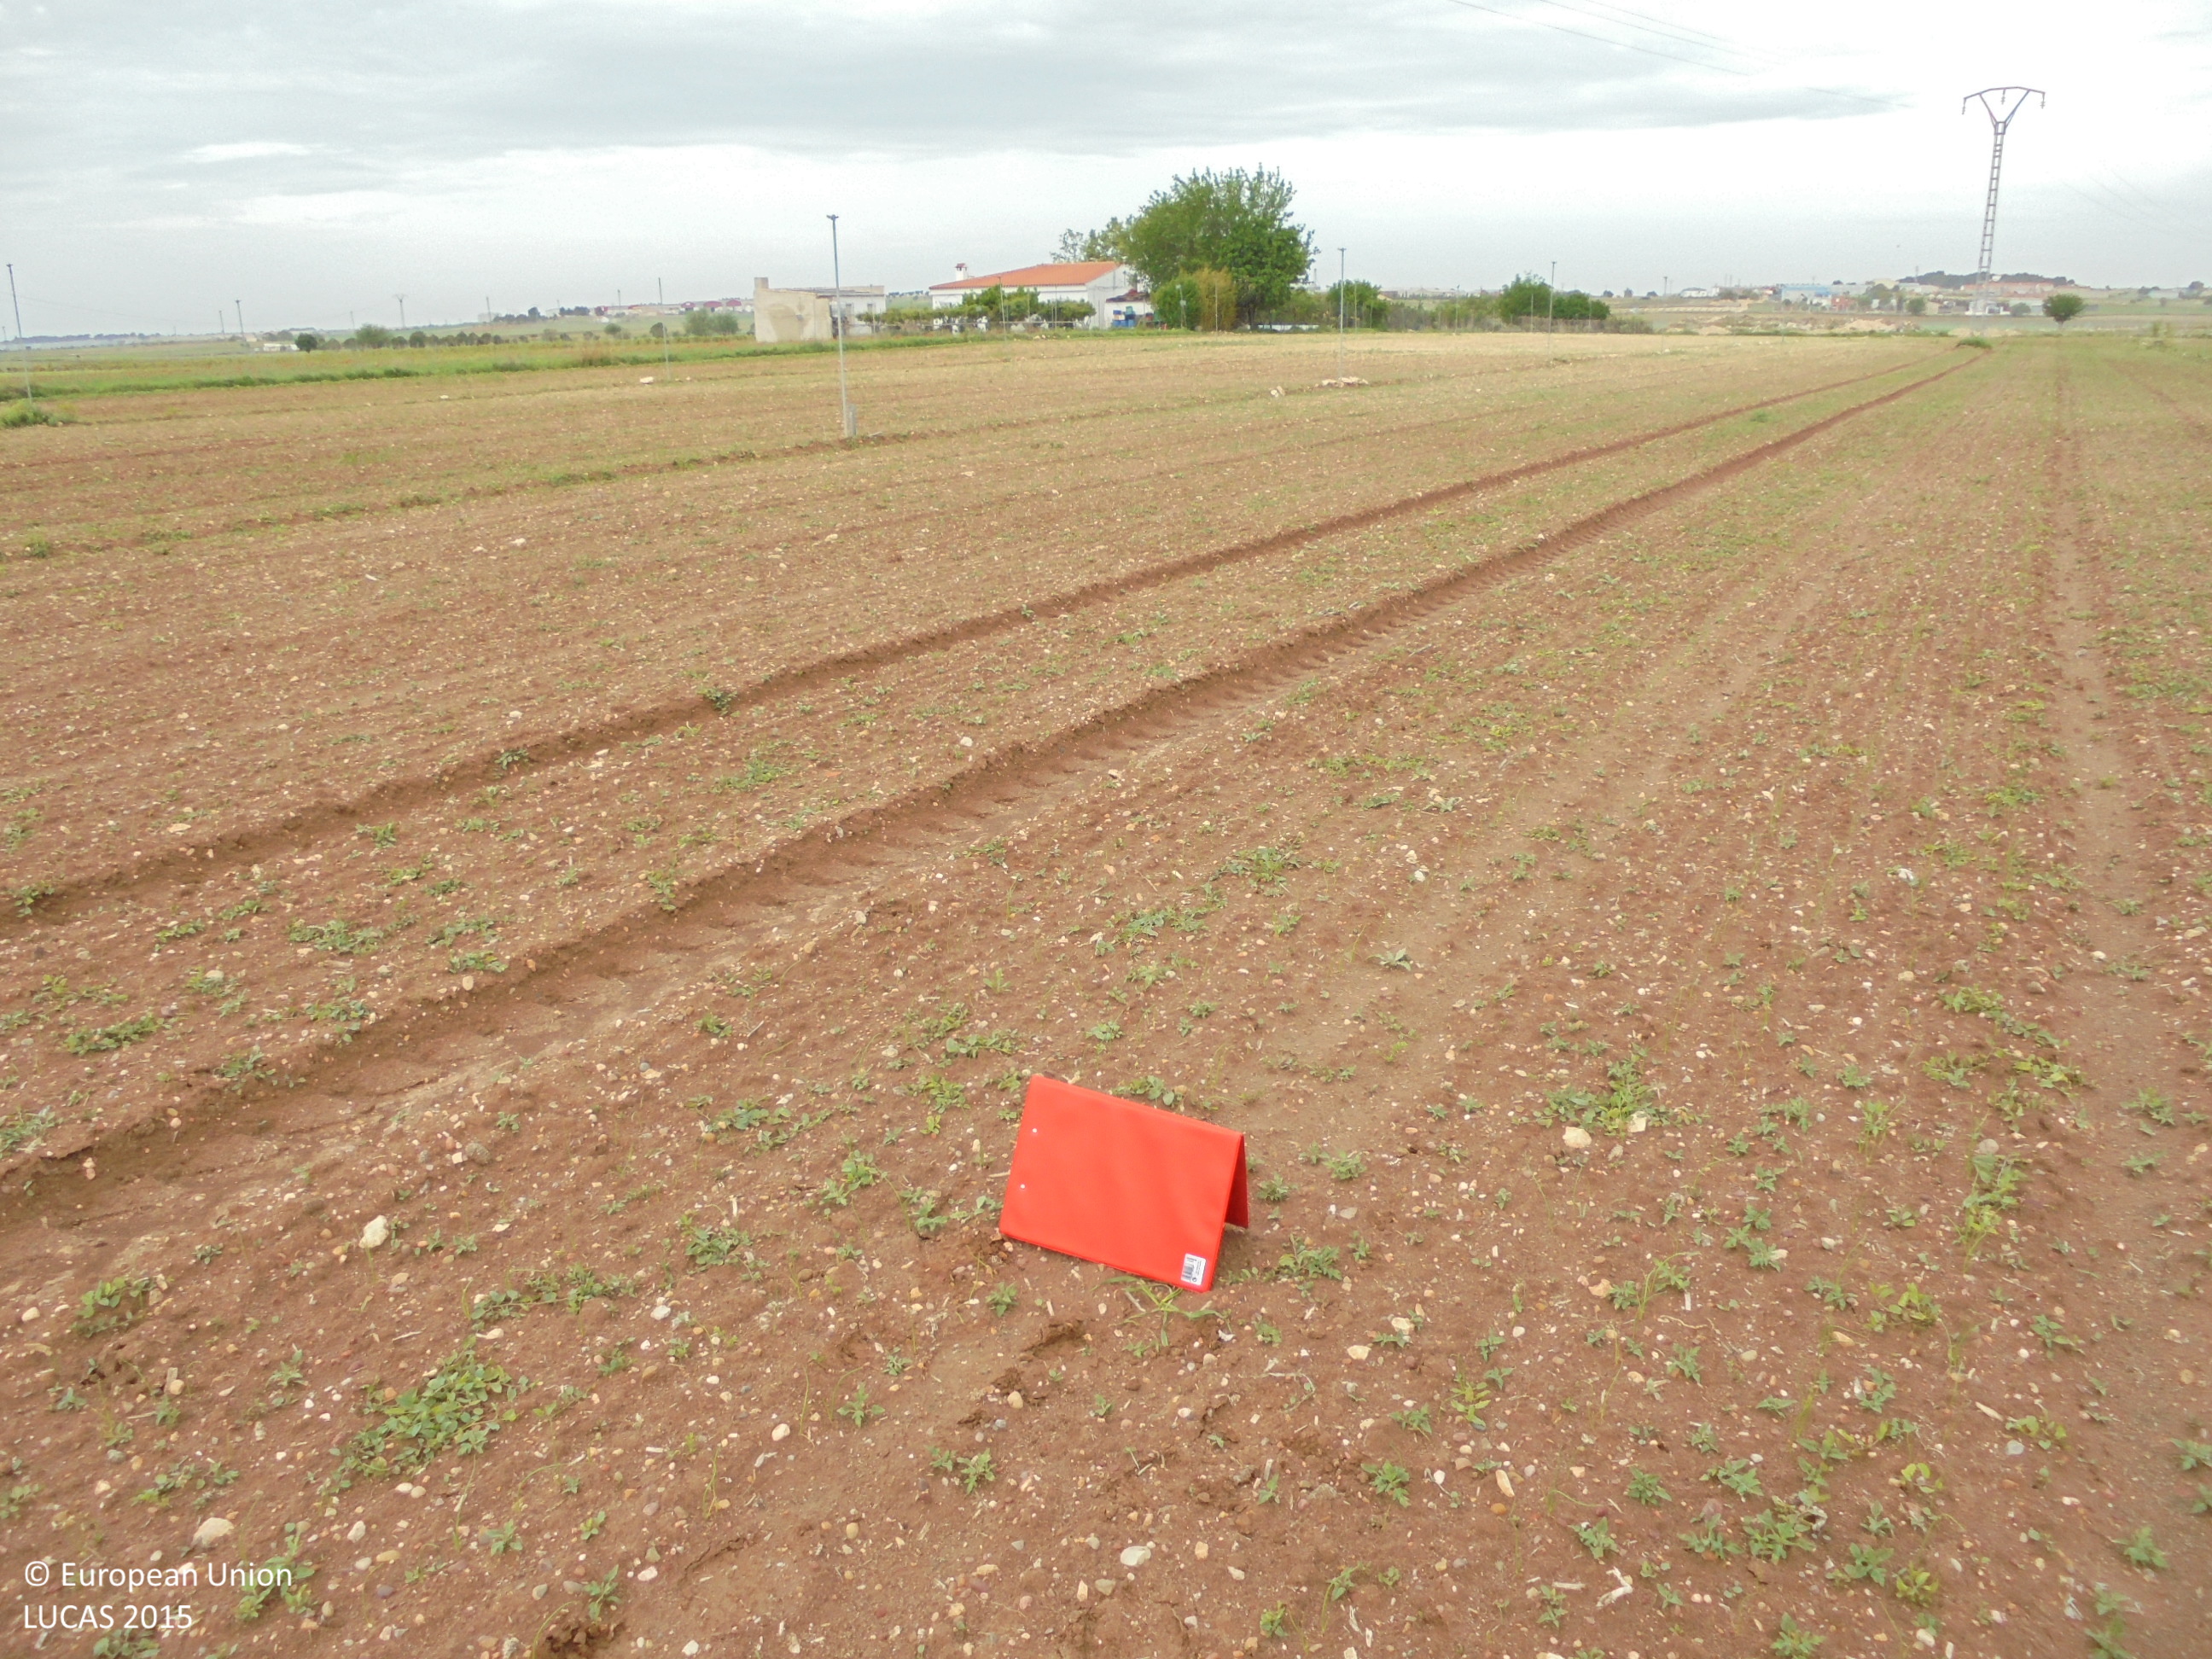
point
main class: Cropland
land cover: Other root crops
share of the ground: < 10 %
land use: Agriculture (excluding fallow land and kitchen gardens)
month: May
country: ES
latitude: 39.2257
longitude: -1.7833
